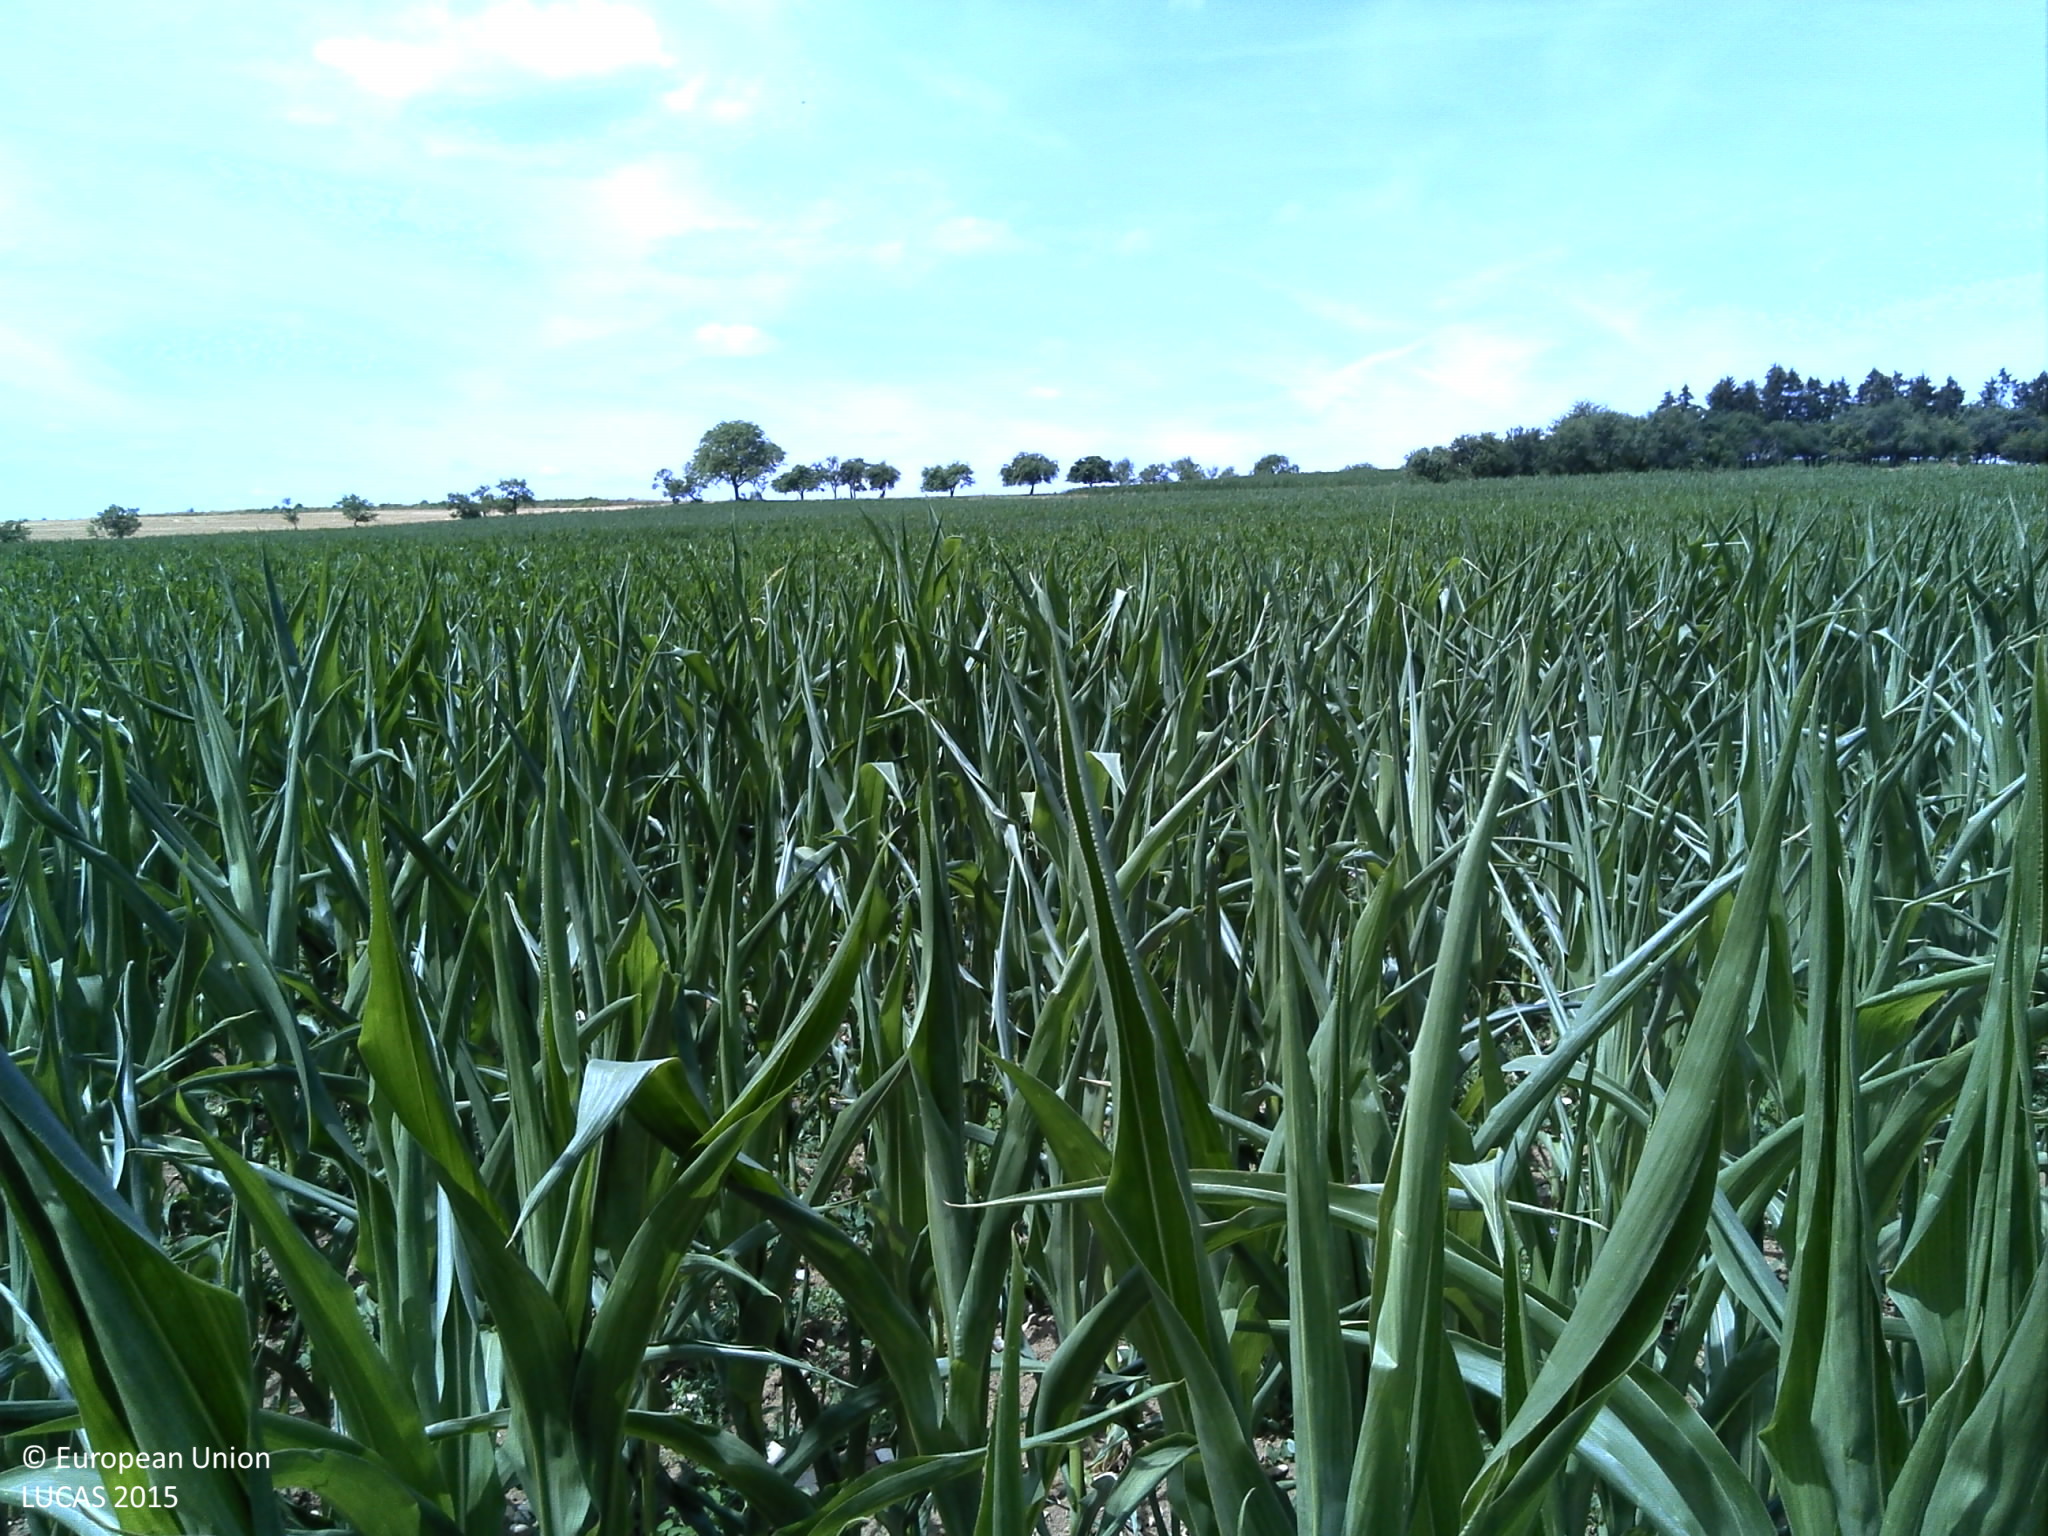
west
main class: Cropland
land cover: Maize
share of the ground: > 75 %
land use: Agriculture (excluding fallow land and kitchen gardens)
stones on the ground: 10 - 25 %
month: July
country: FR
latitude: 48.3663
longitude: 6.5045
